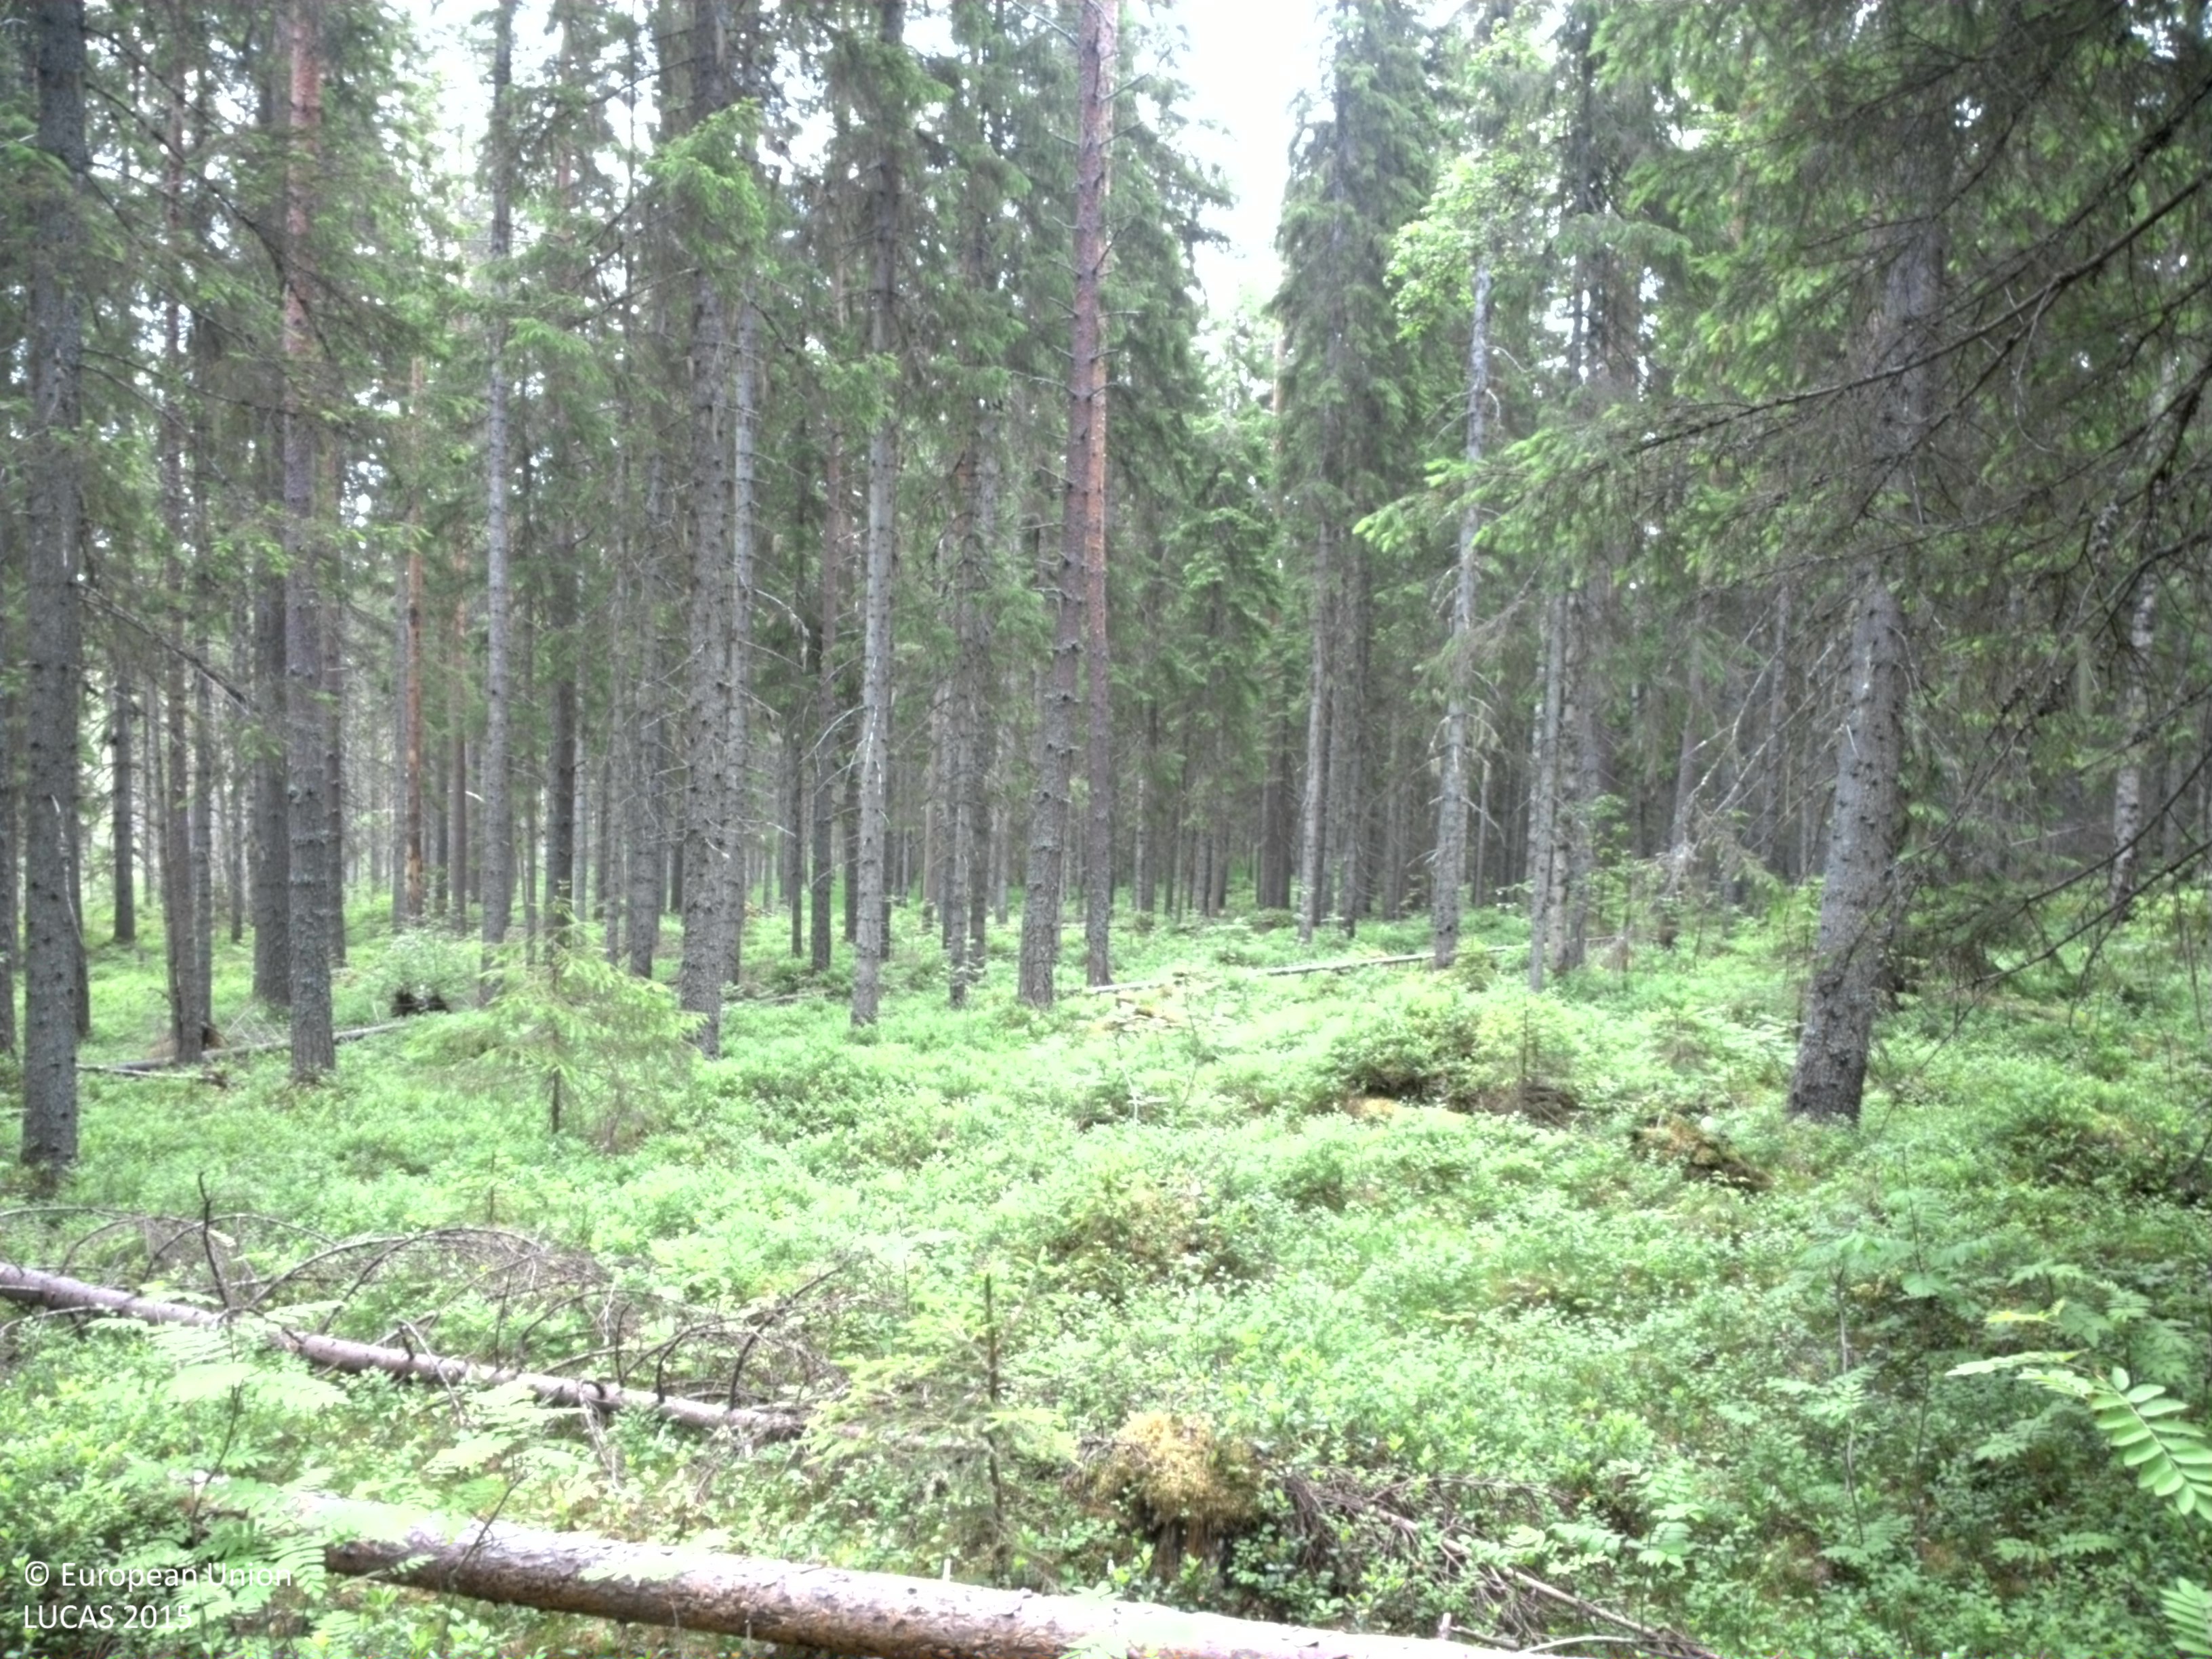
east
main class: Woodland
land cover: Spruce dominated coniferous woodland
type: boreal forest
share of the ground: 50 - 75 %
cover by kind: coniferous forest trees 75 %, shrubs 25 %
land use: Forestry
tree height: > 5 m
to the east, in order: Spruce dominated coniferous woodland; Other mixed woodland; Spruce dominated coniferous woodland; Other mixed woodland; Pine dominated coniferous woodland
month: July
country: SE
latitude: 64.4606
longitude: 20.8944
